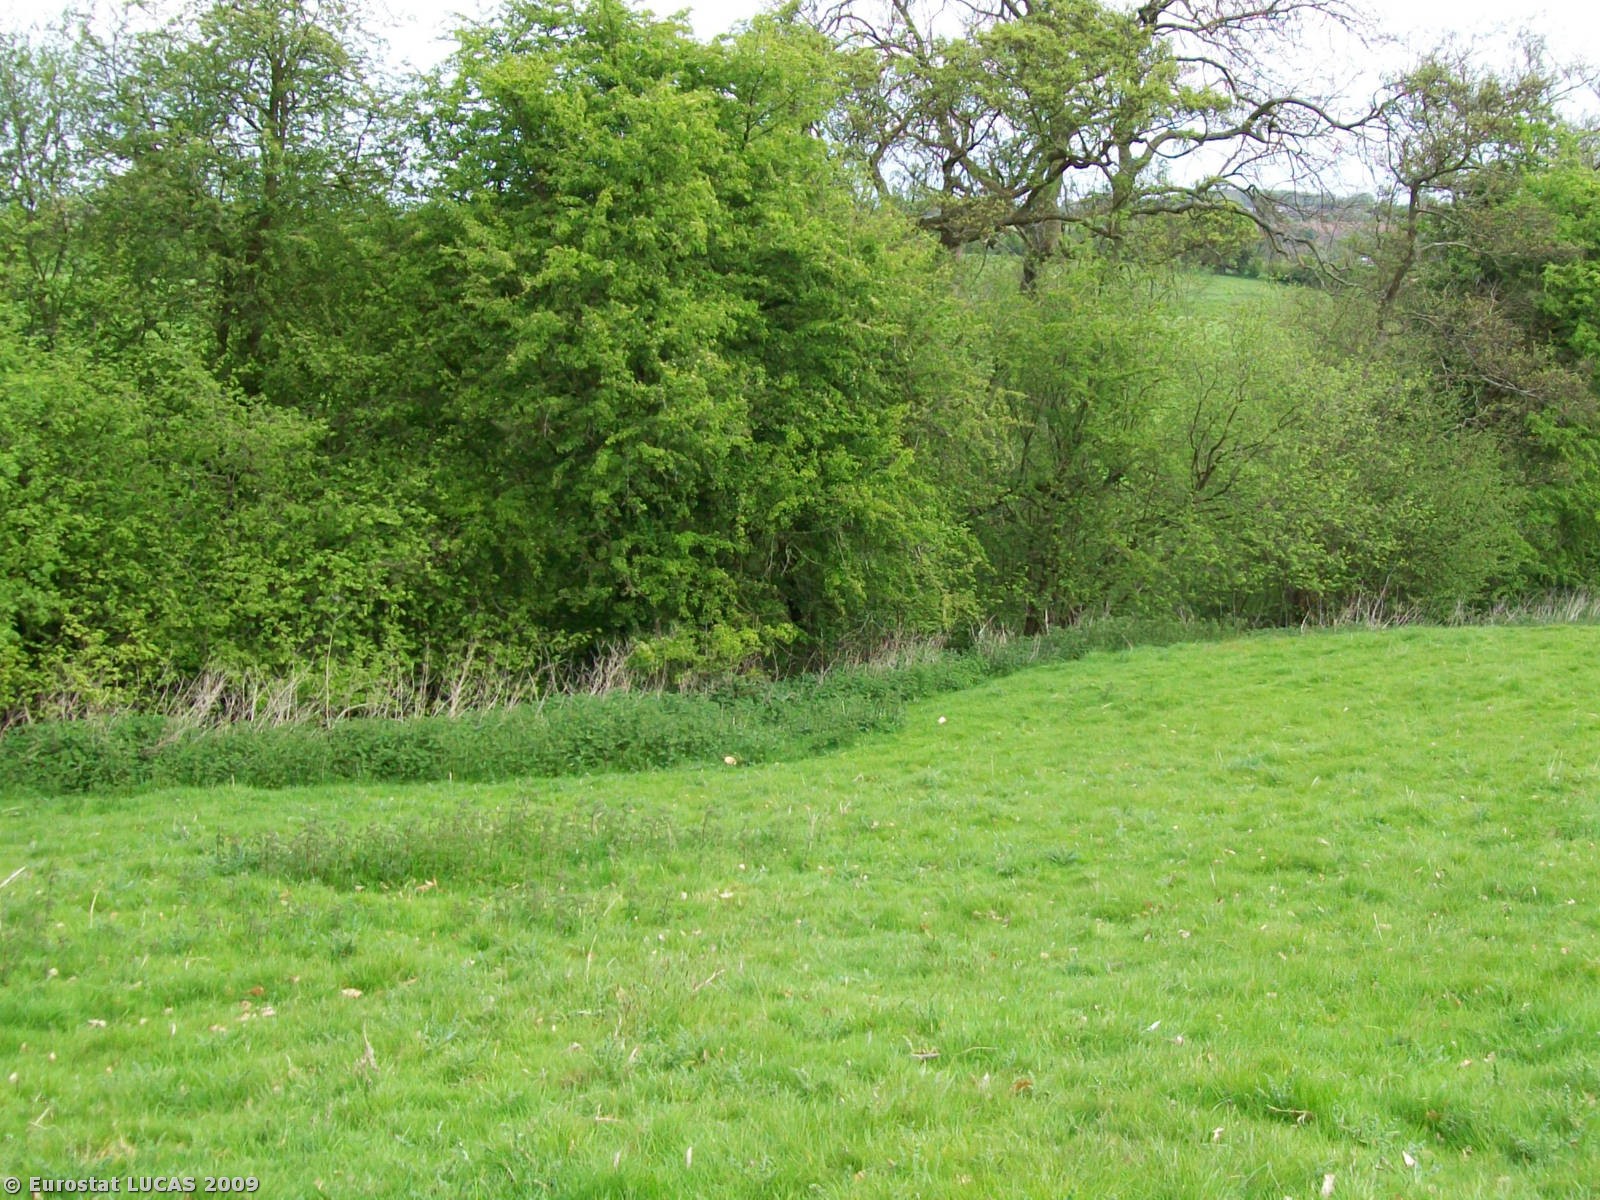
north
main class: Grassland
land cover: Grassland without tree/shrub cover
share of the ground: > 75 %
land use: Agriculture (excluding fallow land and kitchen gardens)
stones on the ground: < 10 %
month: May
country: GB
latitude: 52.3712
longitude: -2.4772
